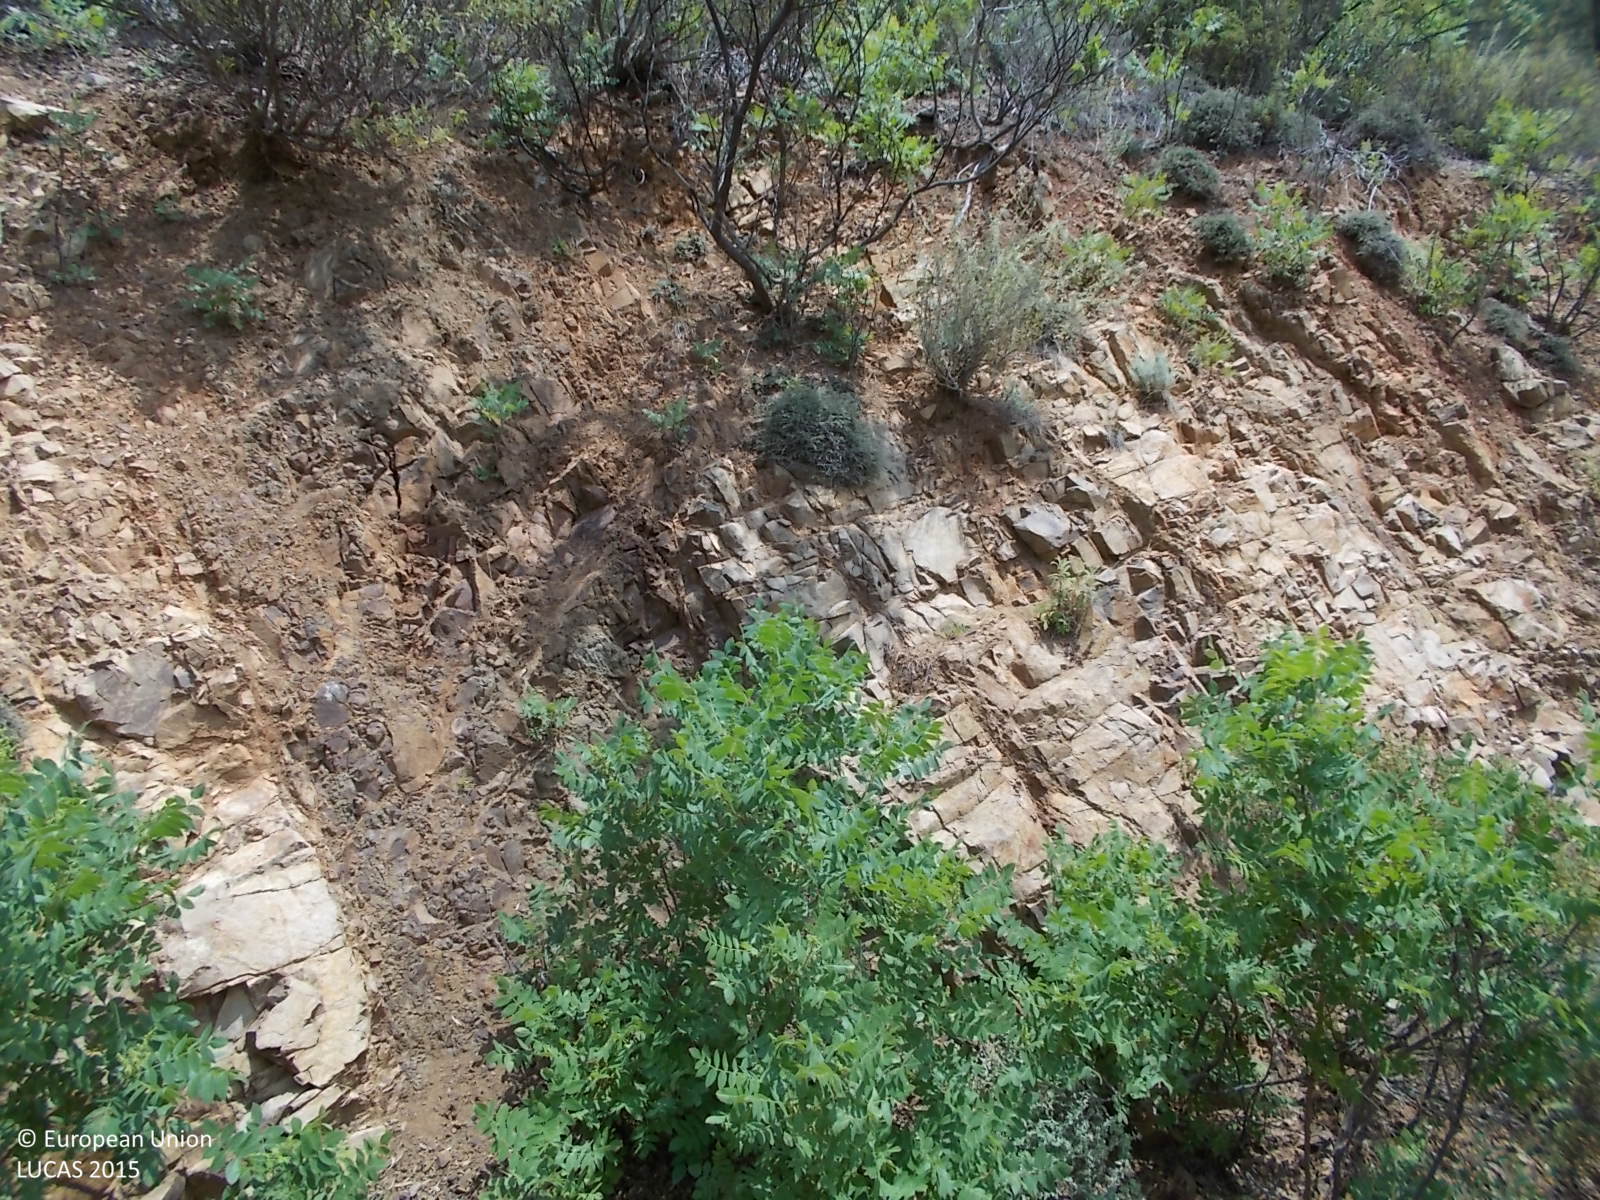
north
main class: Woodland
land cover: Pine dominated mixed woodland
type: coniferous forest of the mediterranean region
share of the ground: 50 - 75 %
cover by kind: coniferous forest trees 40 %, broadleaved forest trees 25 %, shrubs 20 %, unconsolidated bare surface 15 %
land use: Forestry
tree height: > 5 m
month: June
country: CY
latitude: 35.0050
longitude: 32.6109
